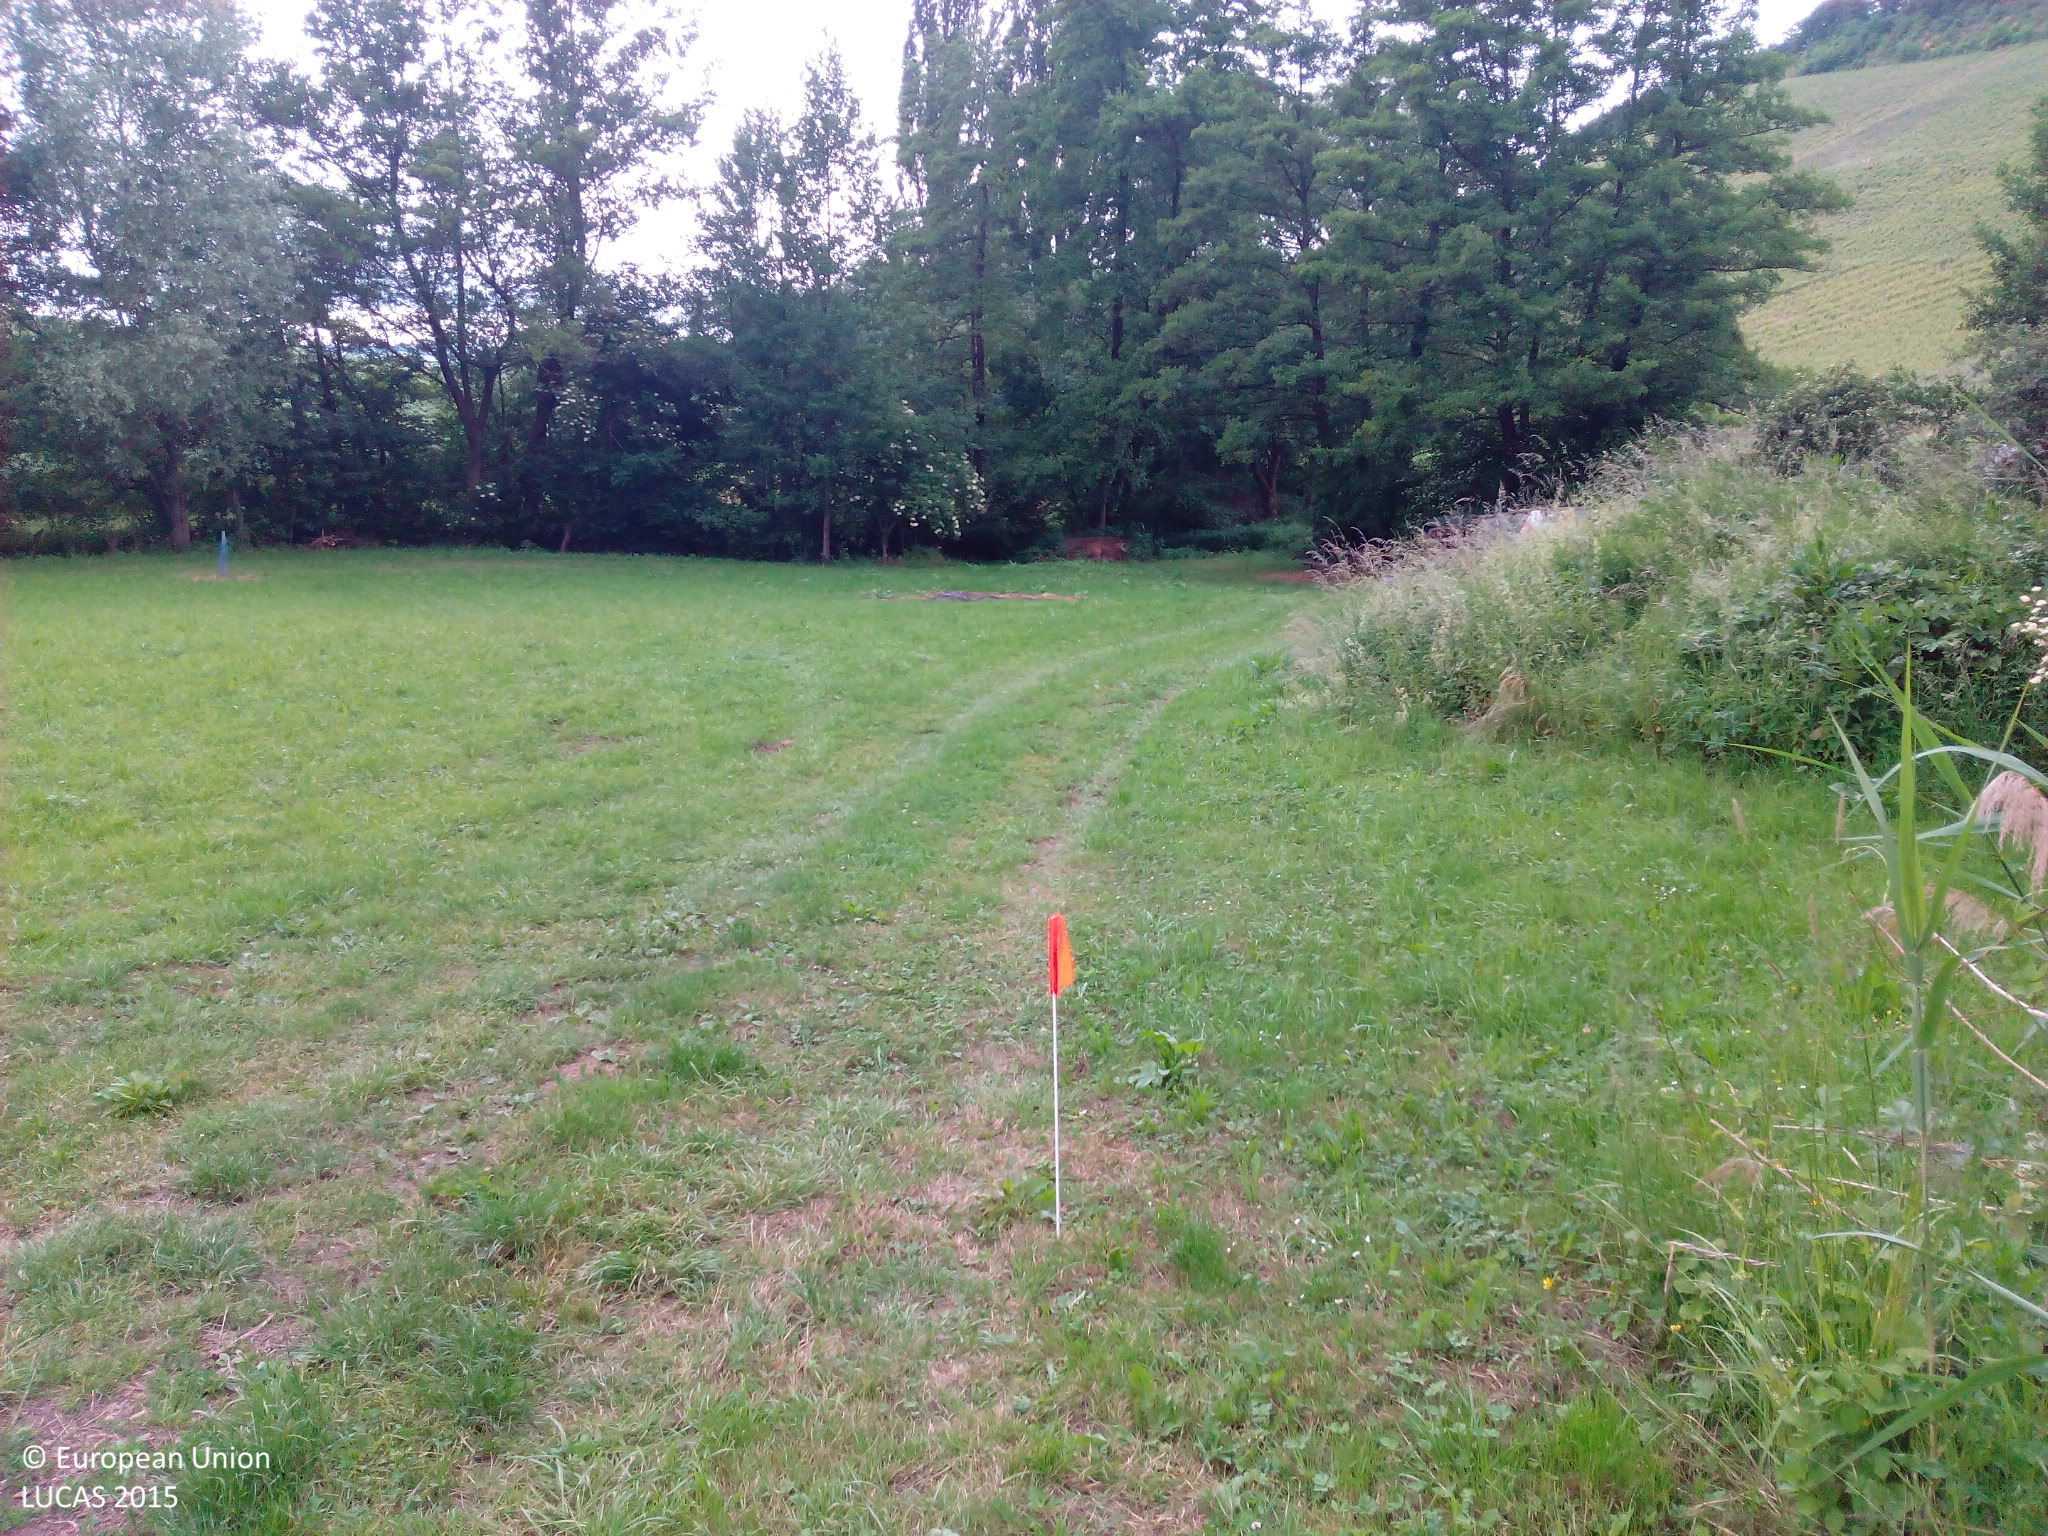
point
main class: Grassland
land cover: Grassland without tree/shrub cover
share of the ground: > 75 %
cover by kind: herbaceous plants 100 %
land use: Agriculture (excluding fallow land and kitchen gardens)
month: June
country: DE
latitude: 49.1216
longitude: 9.4111
